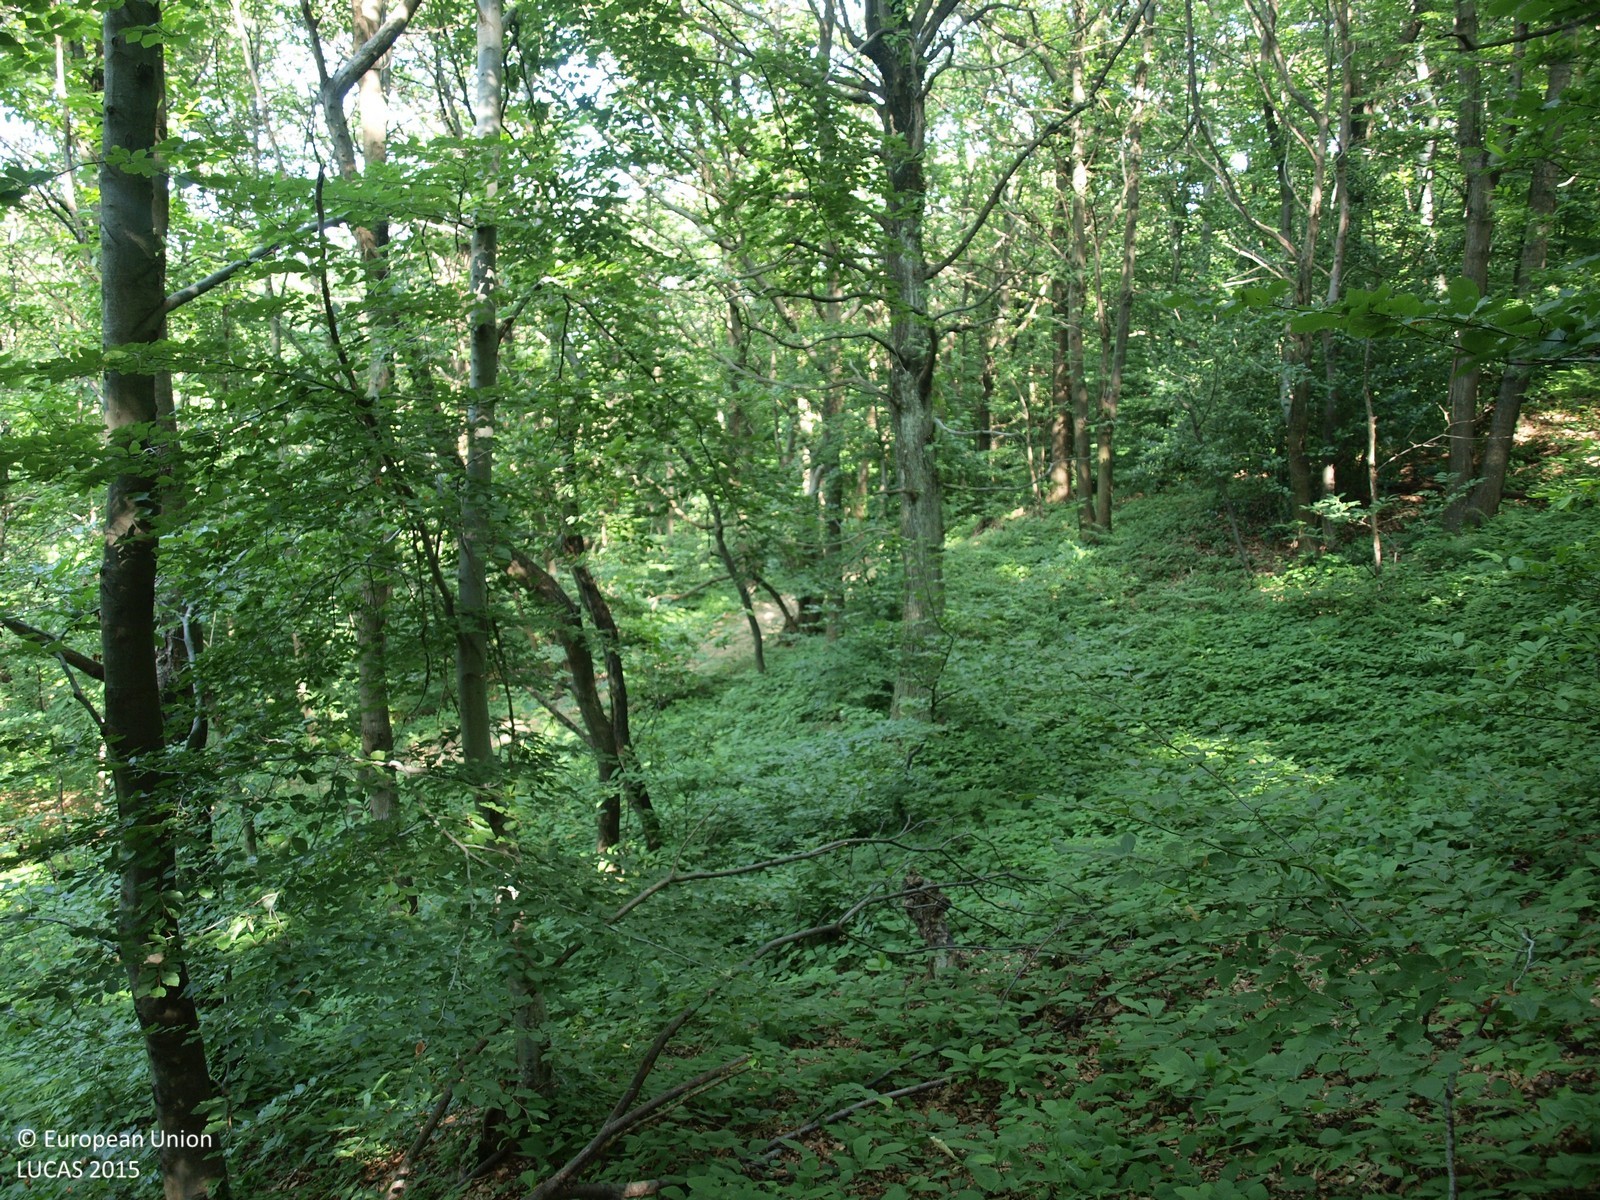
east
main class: Woodland
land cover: Broadleaved woodland
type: mesophytic deciduous forest
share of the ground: > 75 %
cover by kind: broadleaved forest trees 100 %
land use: Forestry
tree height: > 5 m
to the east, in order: Broadleaved woodland; Tracks; Broadleaved woodland; Tracks; Broadleaved woodland
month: July
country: HR
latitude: 45.7482
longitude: 15.6916
